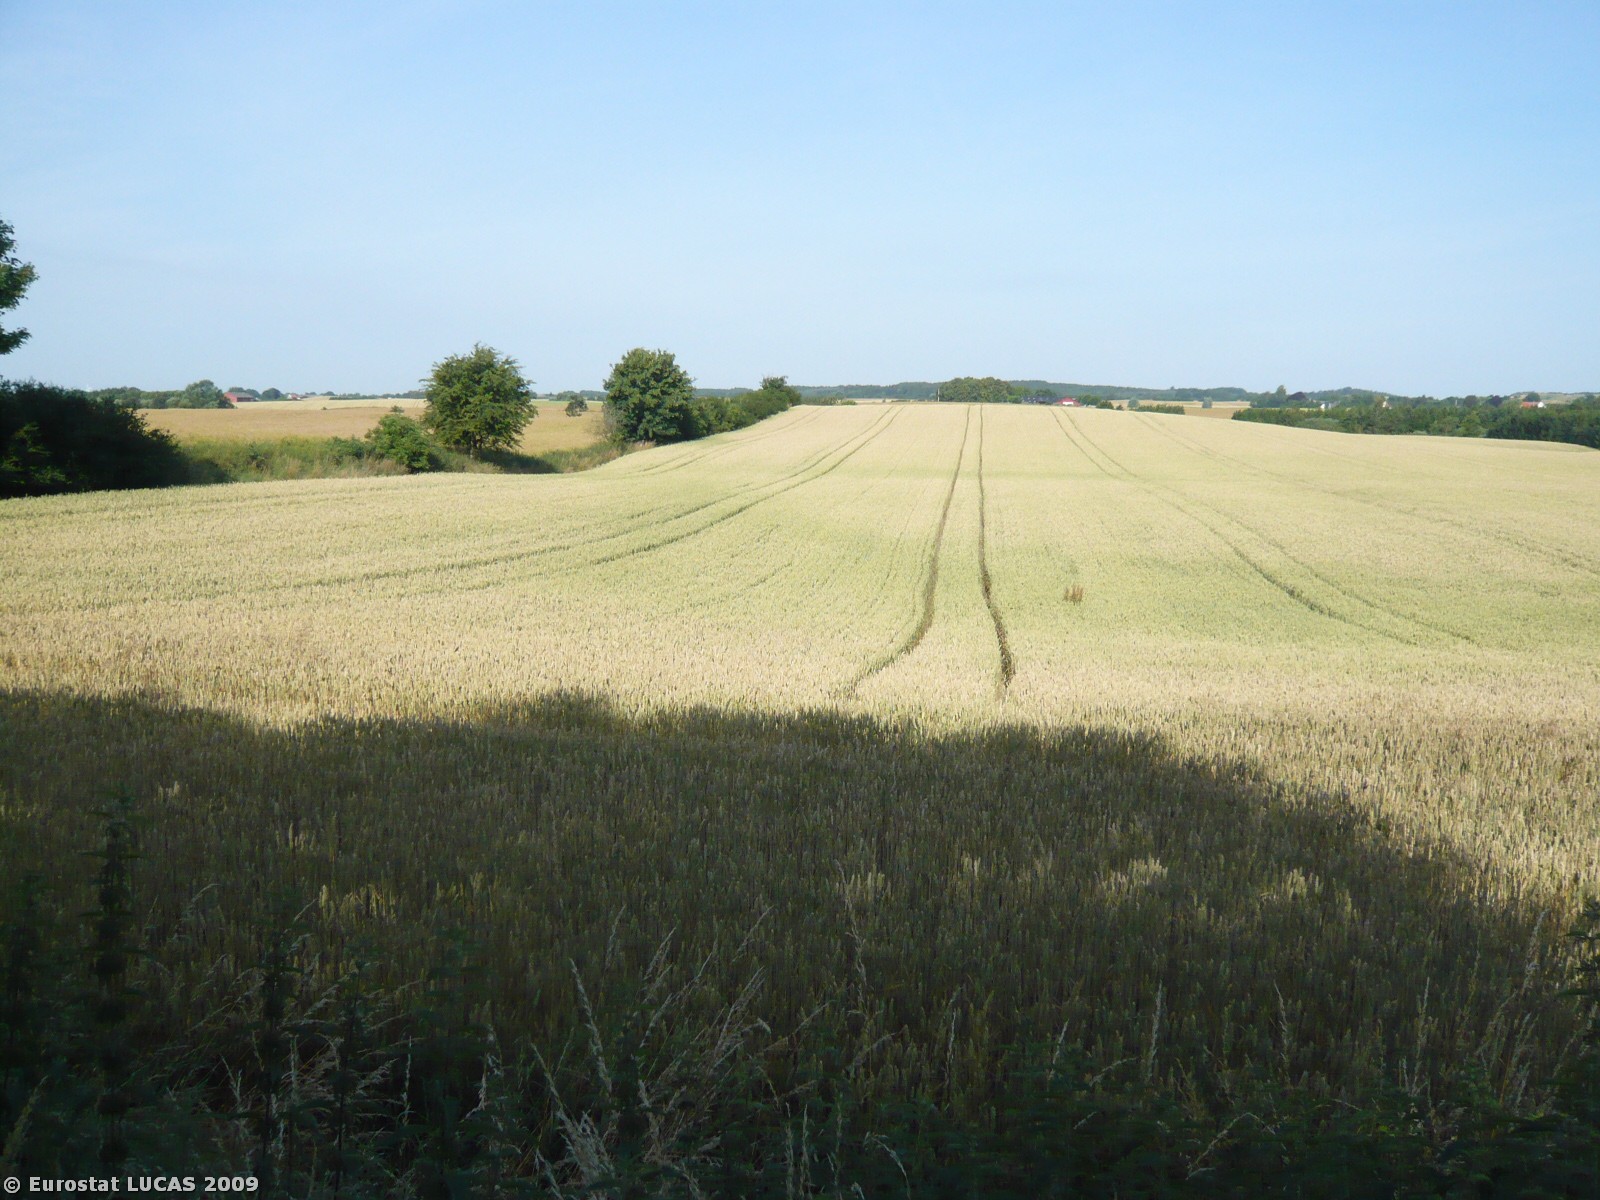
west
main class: Cropland
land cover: Common wheat
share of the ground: > 75 %
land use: Agriculture (excluding fallow land and kitchen gardens)
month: July
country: DK
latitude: 55.6008
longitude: 11.7284
